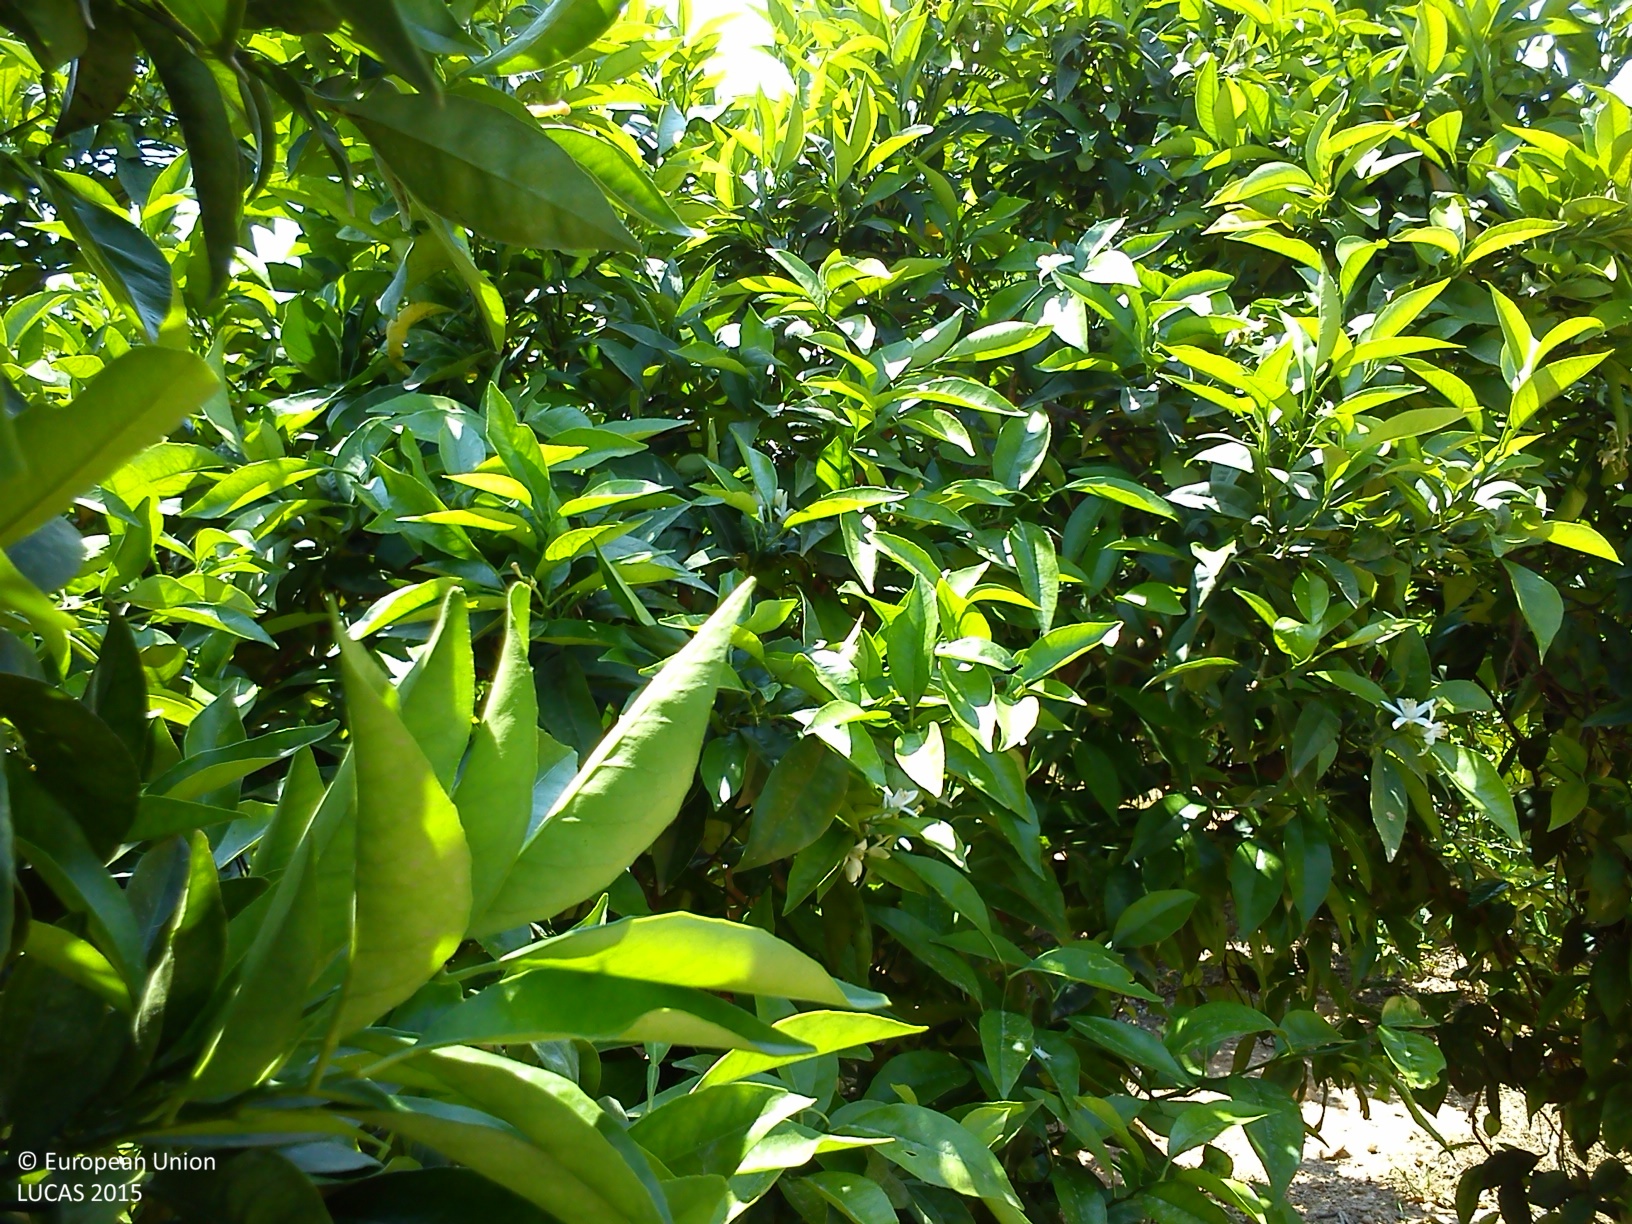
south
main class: Cropland
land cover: Oranges
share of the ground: 50 - 75 %
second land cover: Spontaneously vegetated surfaces
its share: < 10 %
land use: Agriculture (excluding fallow land and kitchen gardens)
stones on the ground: 10 - 25 %
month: April
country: ES
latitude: 39.6250
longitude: -0.7067
